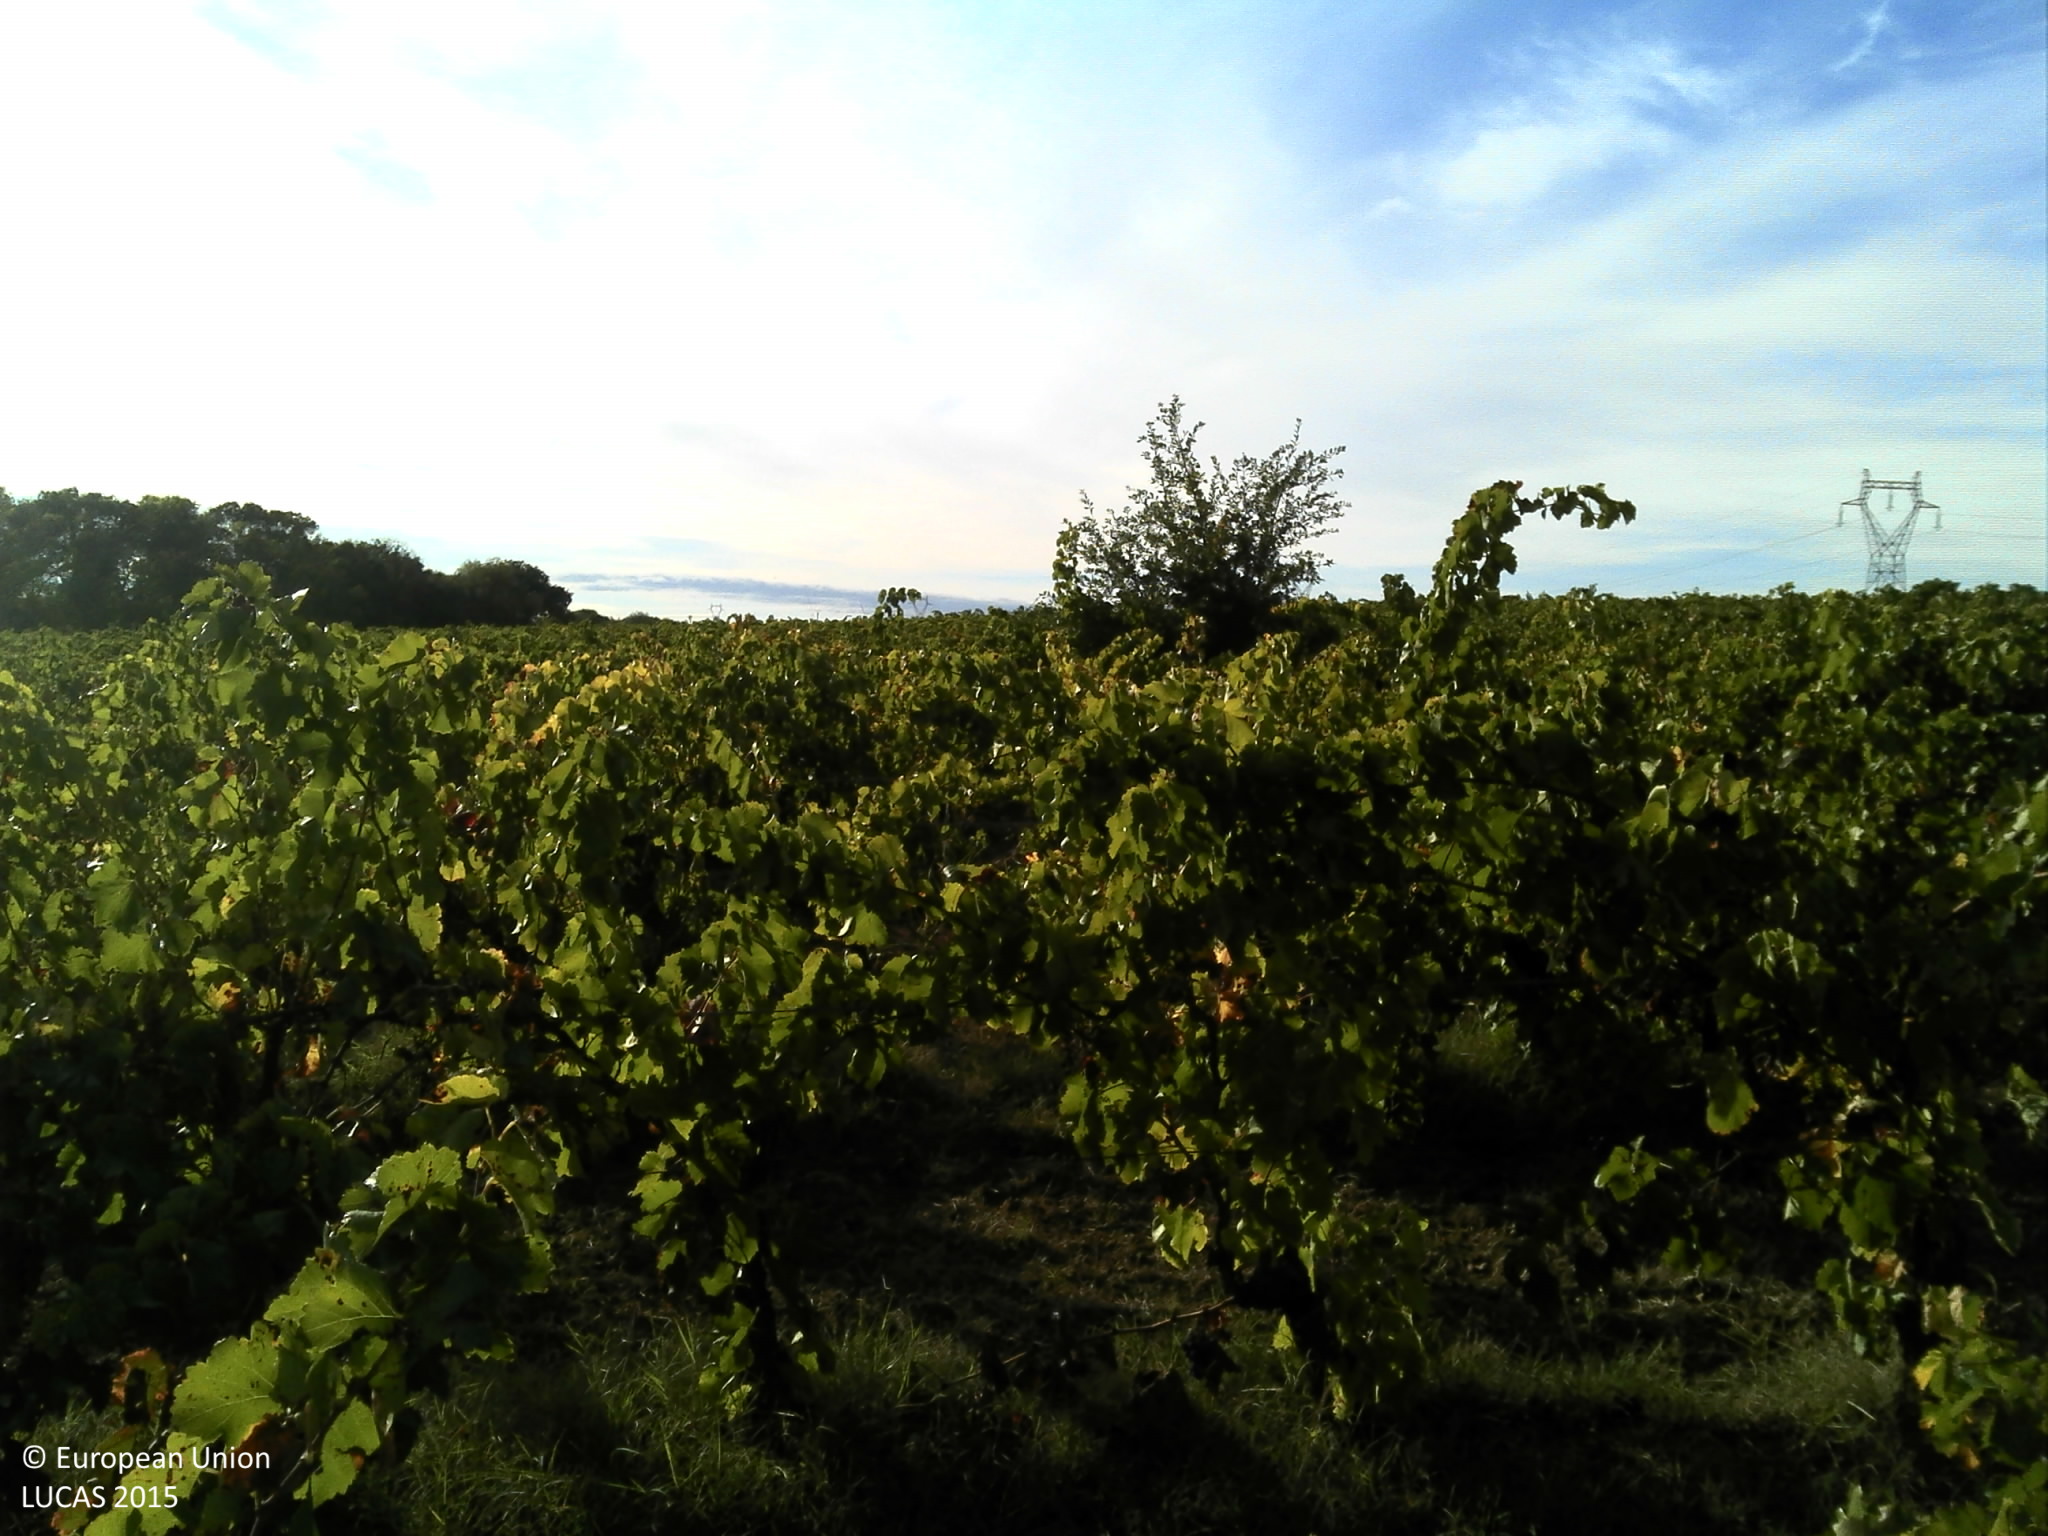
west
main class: Cropland
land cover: Vineyards
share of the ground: 10 - 25 %
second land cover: Other bare soil
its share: > 75 %
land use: Agriculture (excluding fallow land and kitchen gardens)
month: October
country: FR
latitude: 43.3939
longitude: 3.3303
